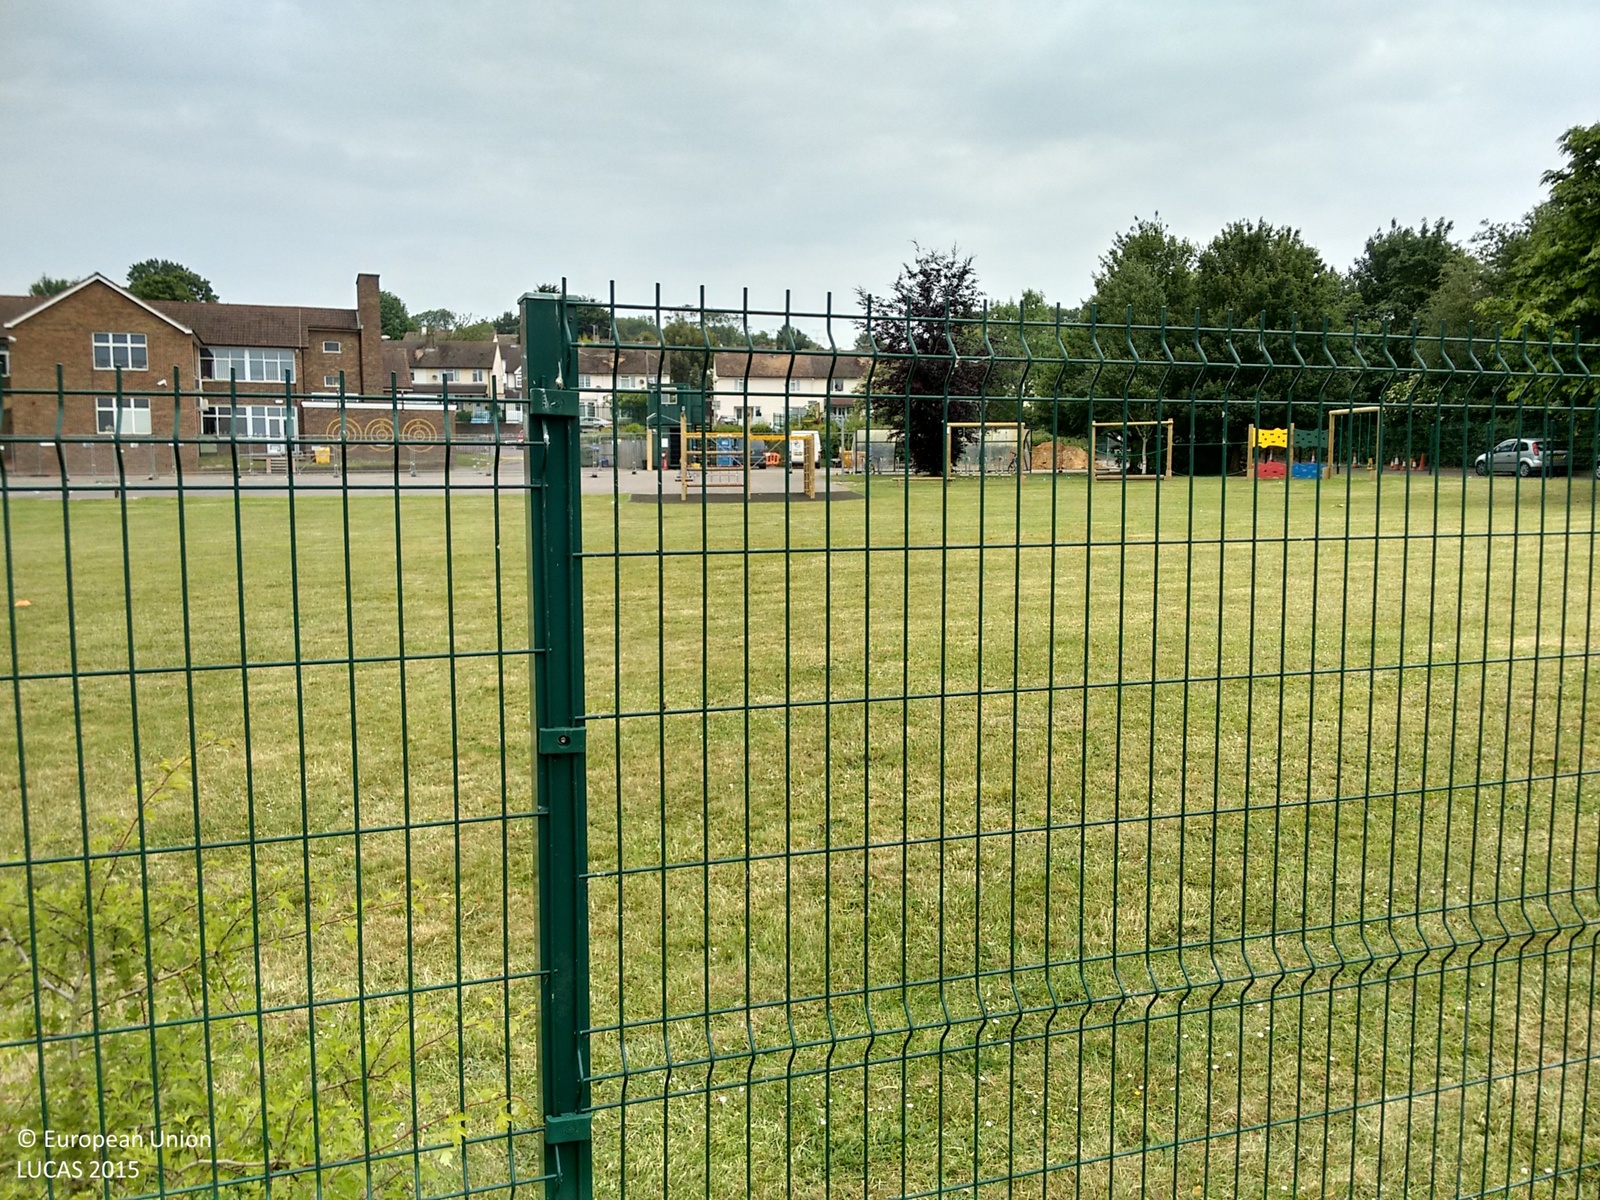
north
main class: Grassland
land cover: Grassland without tree/shrub cover
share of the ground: > 75 %
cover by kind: herbaceous plants 100 %
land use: Community services
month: June
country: GB
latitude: 51.4422
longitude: -1.0514
